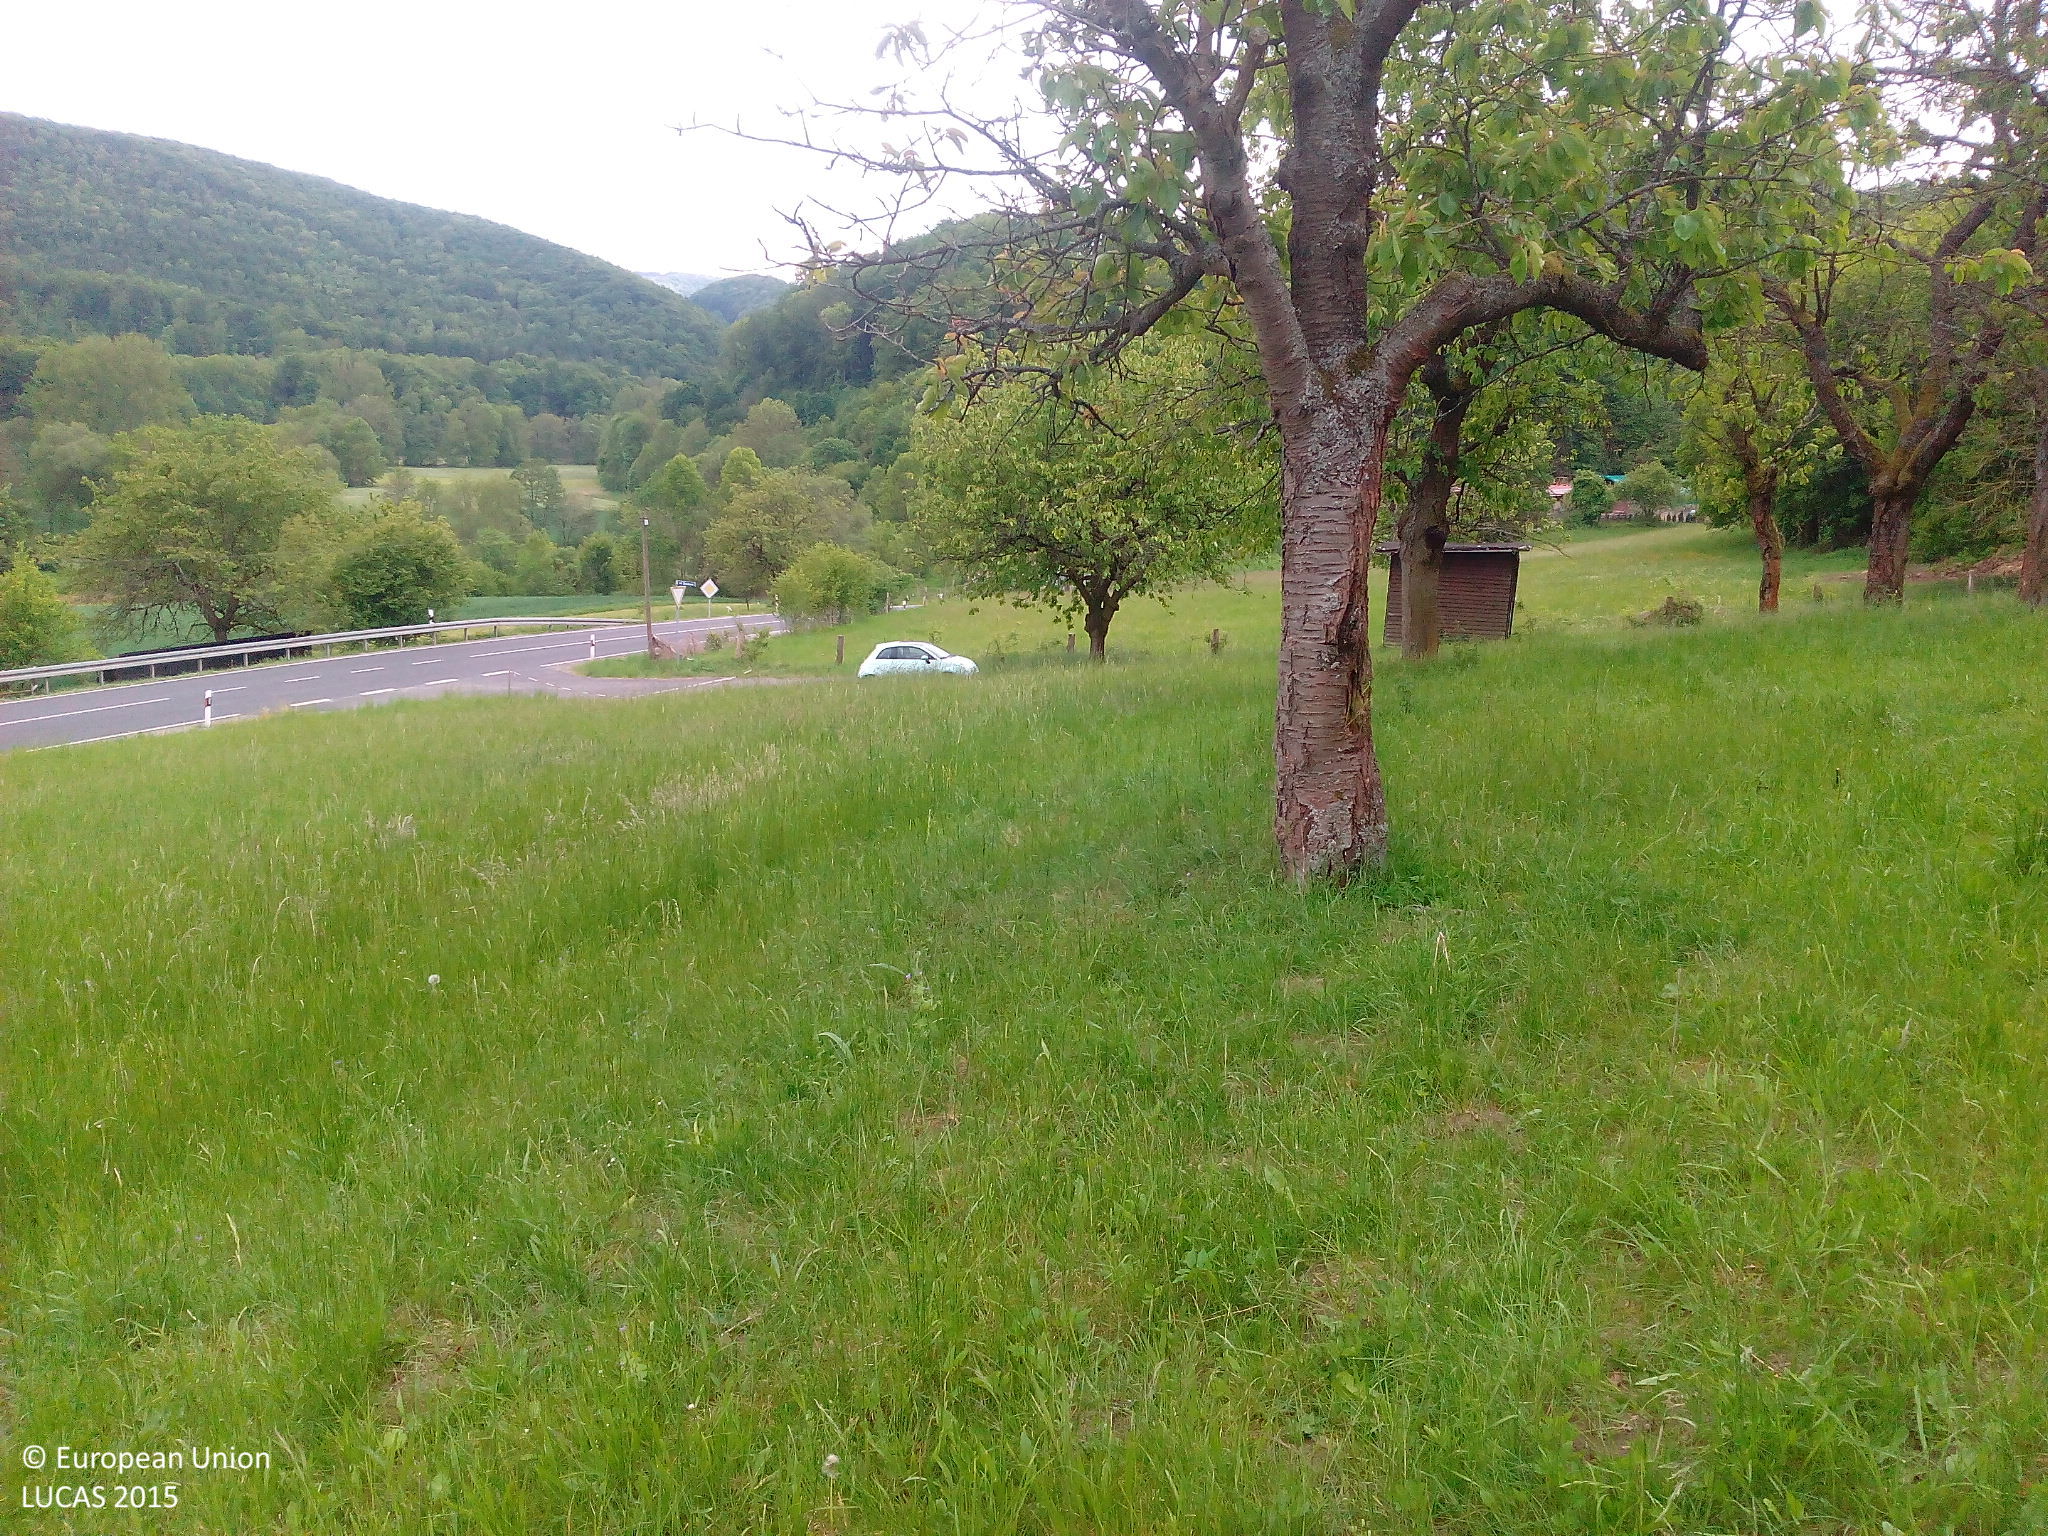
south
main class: Cropland
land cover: Cherry fruit
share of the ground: 25 - 50 %
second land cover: Grassland without tree/shrub cover
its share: > 75 %
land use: Agriculture (excluding fallow land and kitchen gardens)
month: May
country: DE
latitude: 51.2809
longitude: 9.8423
